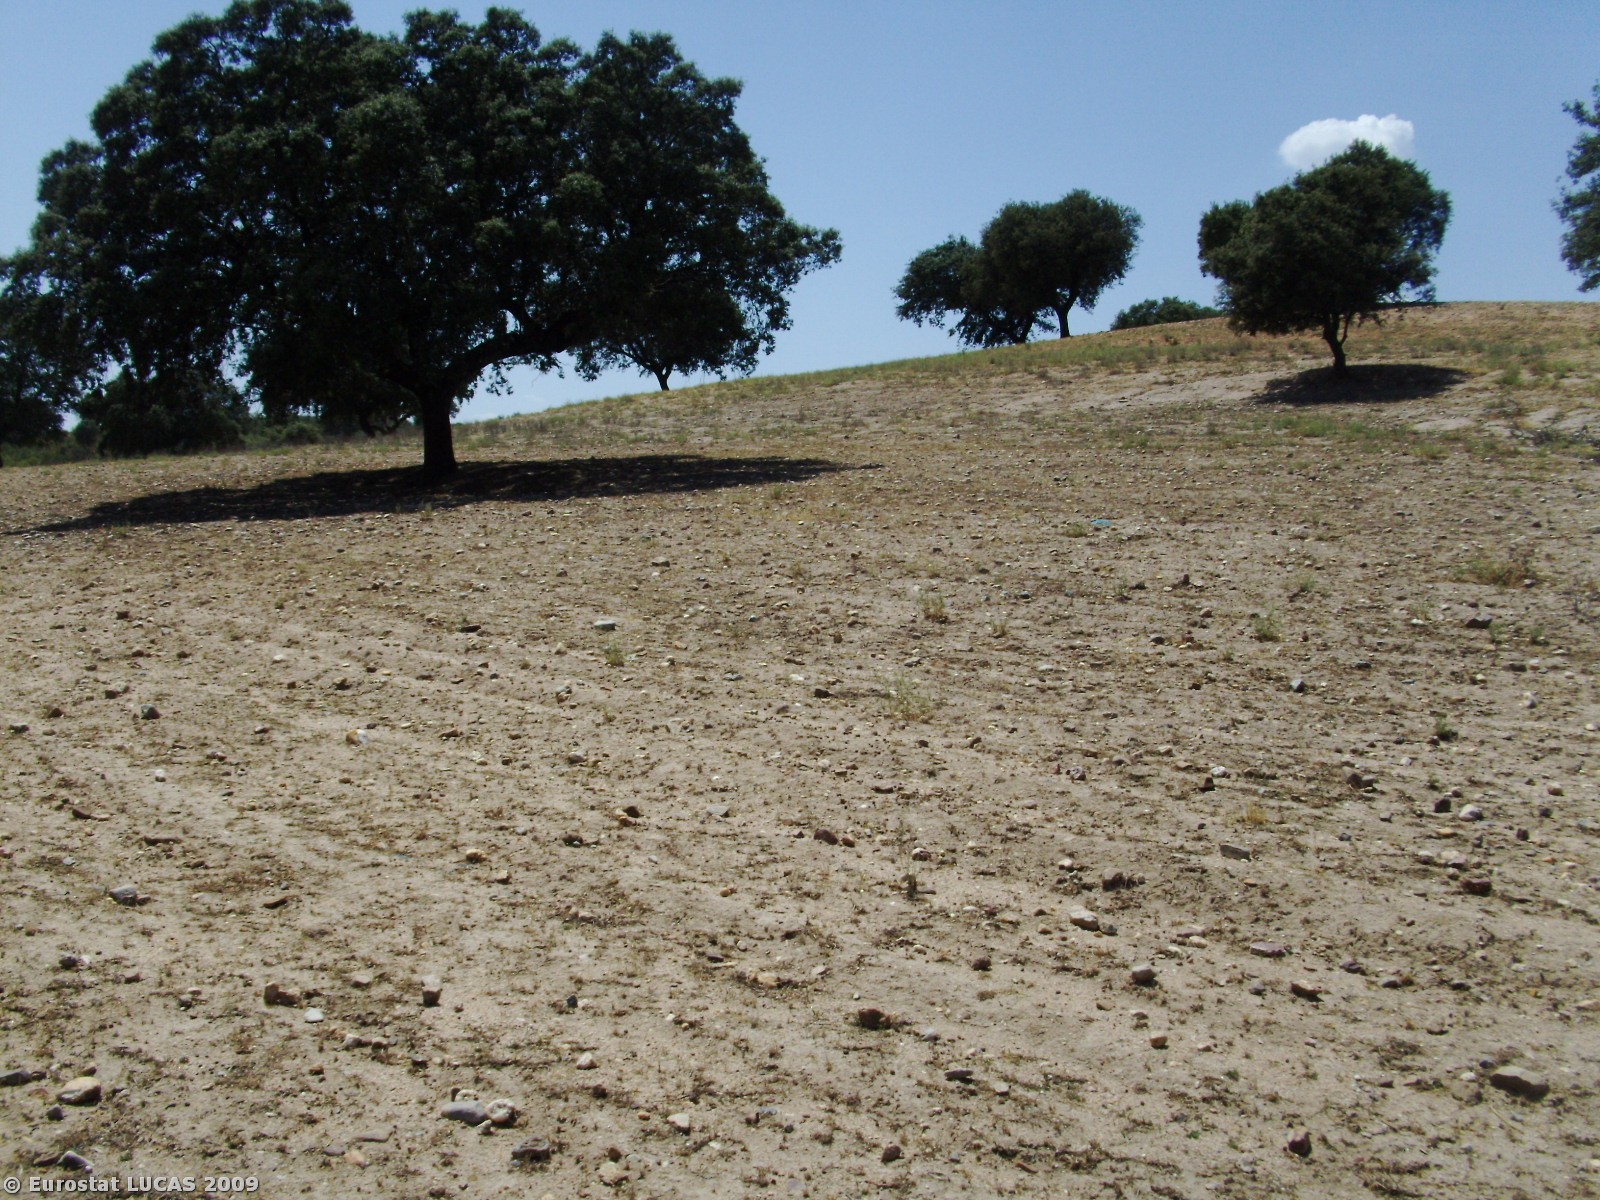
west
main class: Bare land
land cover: Bare land
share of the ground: > 75 %
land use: Fallow land
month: June
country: PT
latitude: 39.7602
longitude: -7.1432
